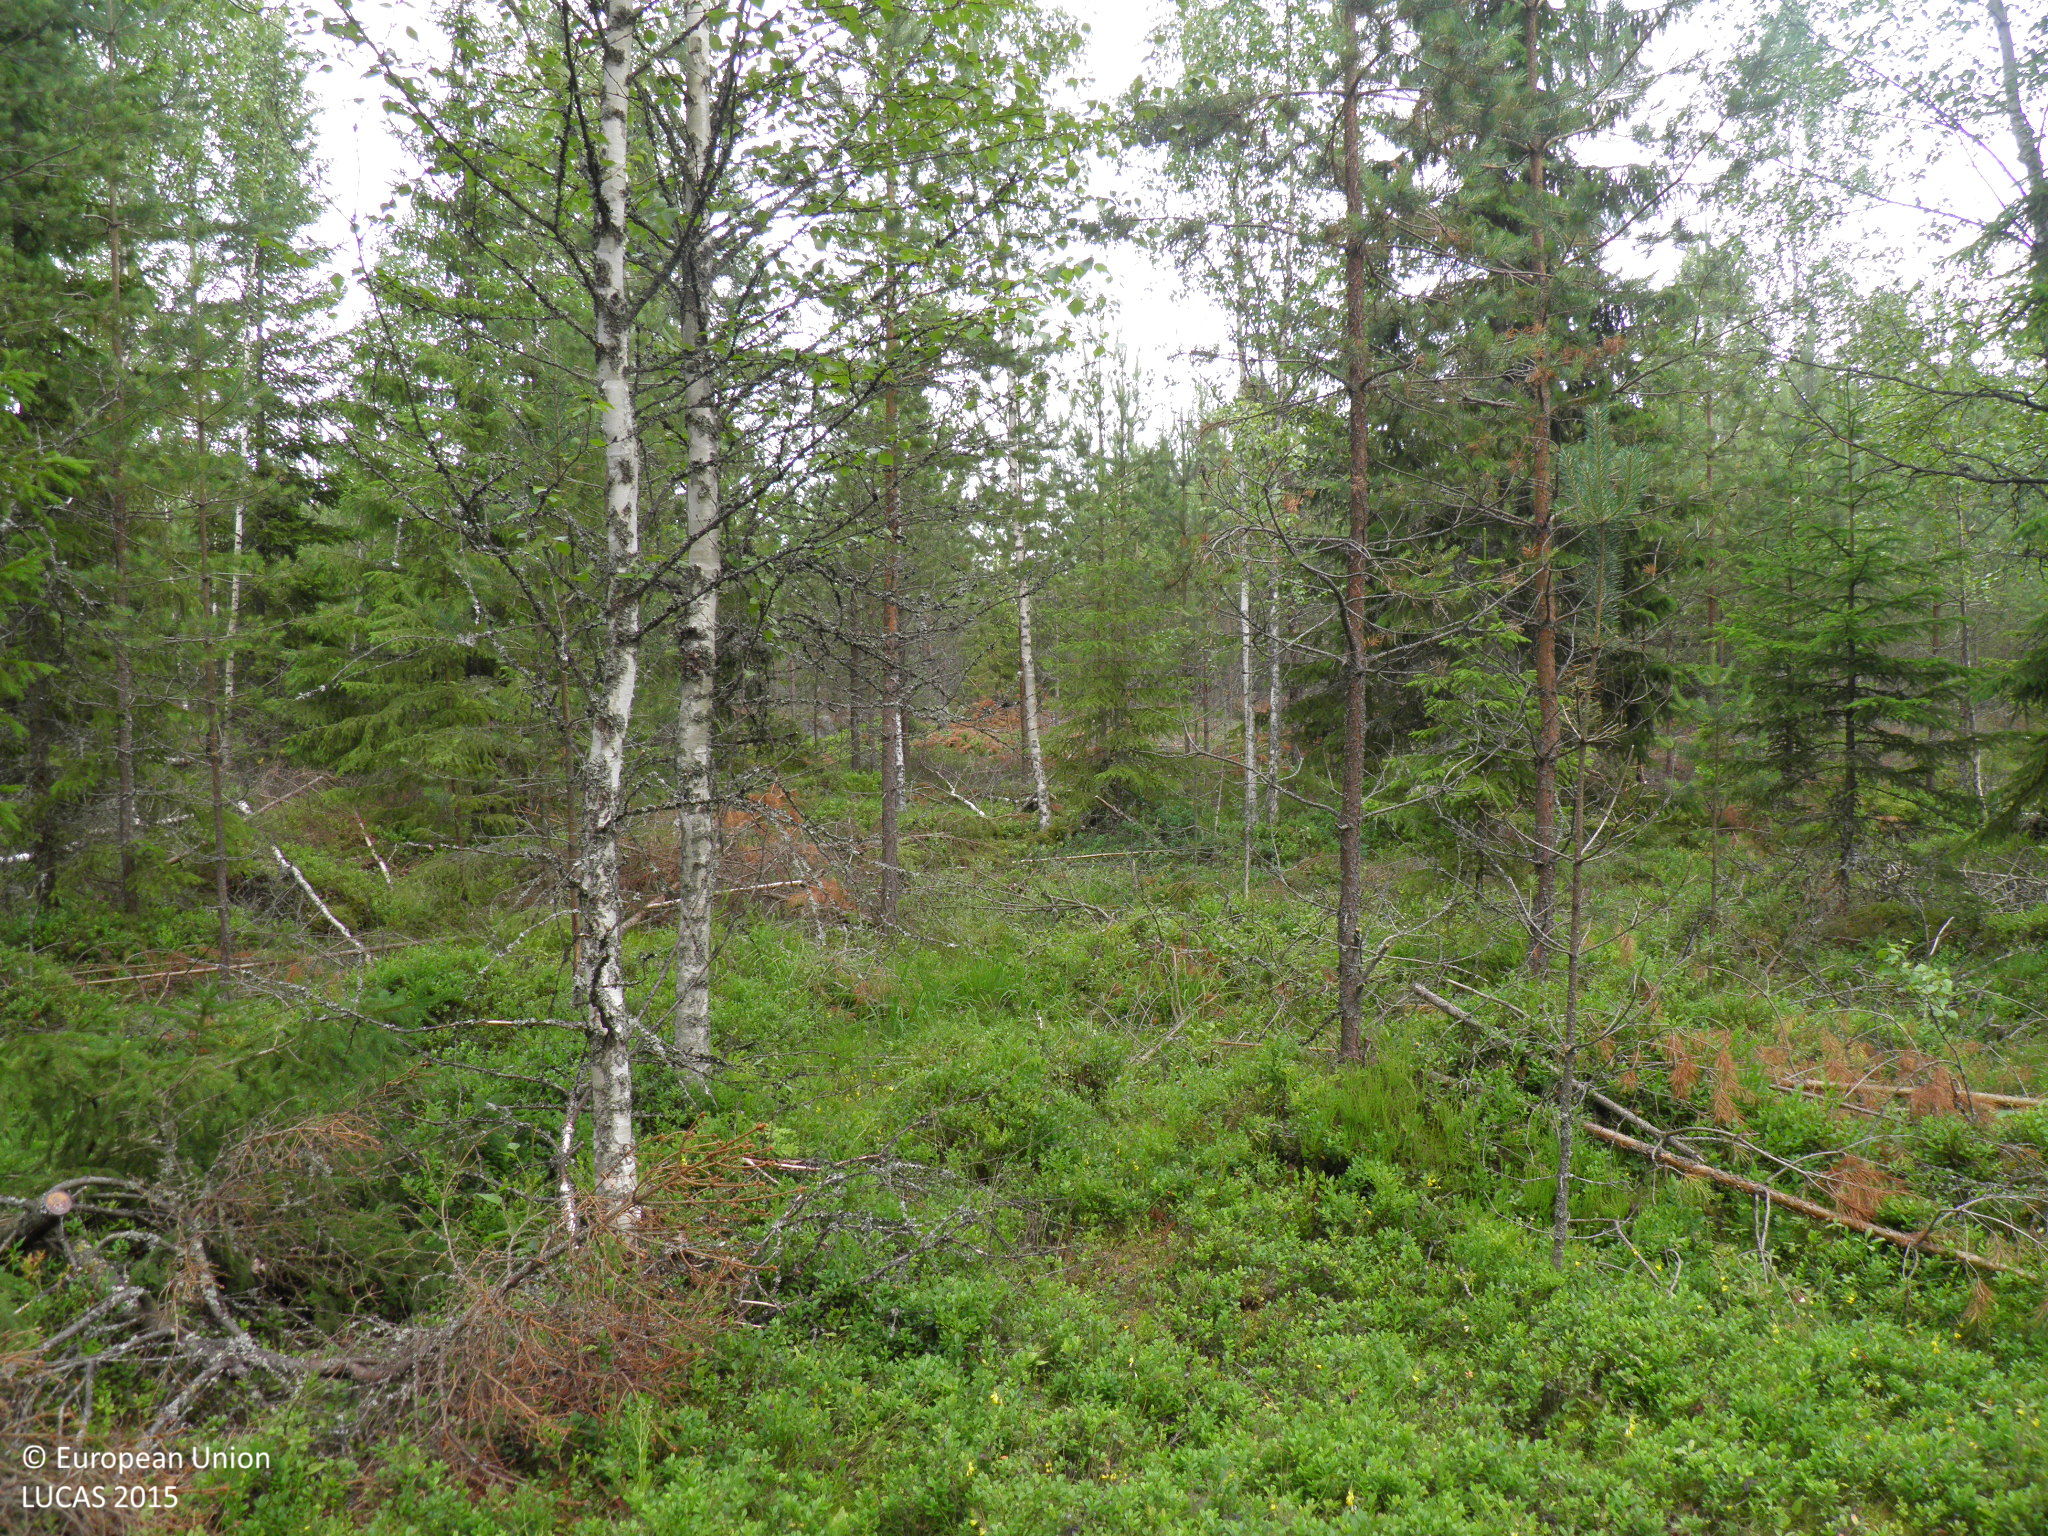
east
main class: Woodland
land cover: Other mixed woodland
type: hemiboreal forest and nemoral coniferous forest and mixed broadleaved-coniferous forest
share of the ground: 50 - 75 %
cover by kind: shrubs 50 %, coniferous forest trees 25 %, broadleaved forest trees 25 %
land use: Forestry
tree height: > 5 m
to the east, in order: Other mixed woodland; Broadleaved woodland
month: July
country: FI
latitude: 60.7327
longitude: 22.7433
